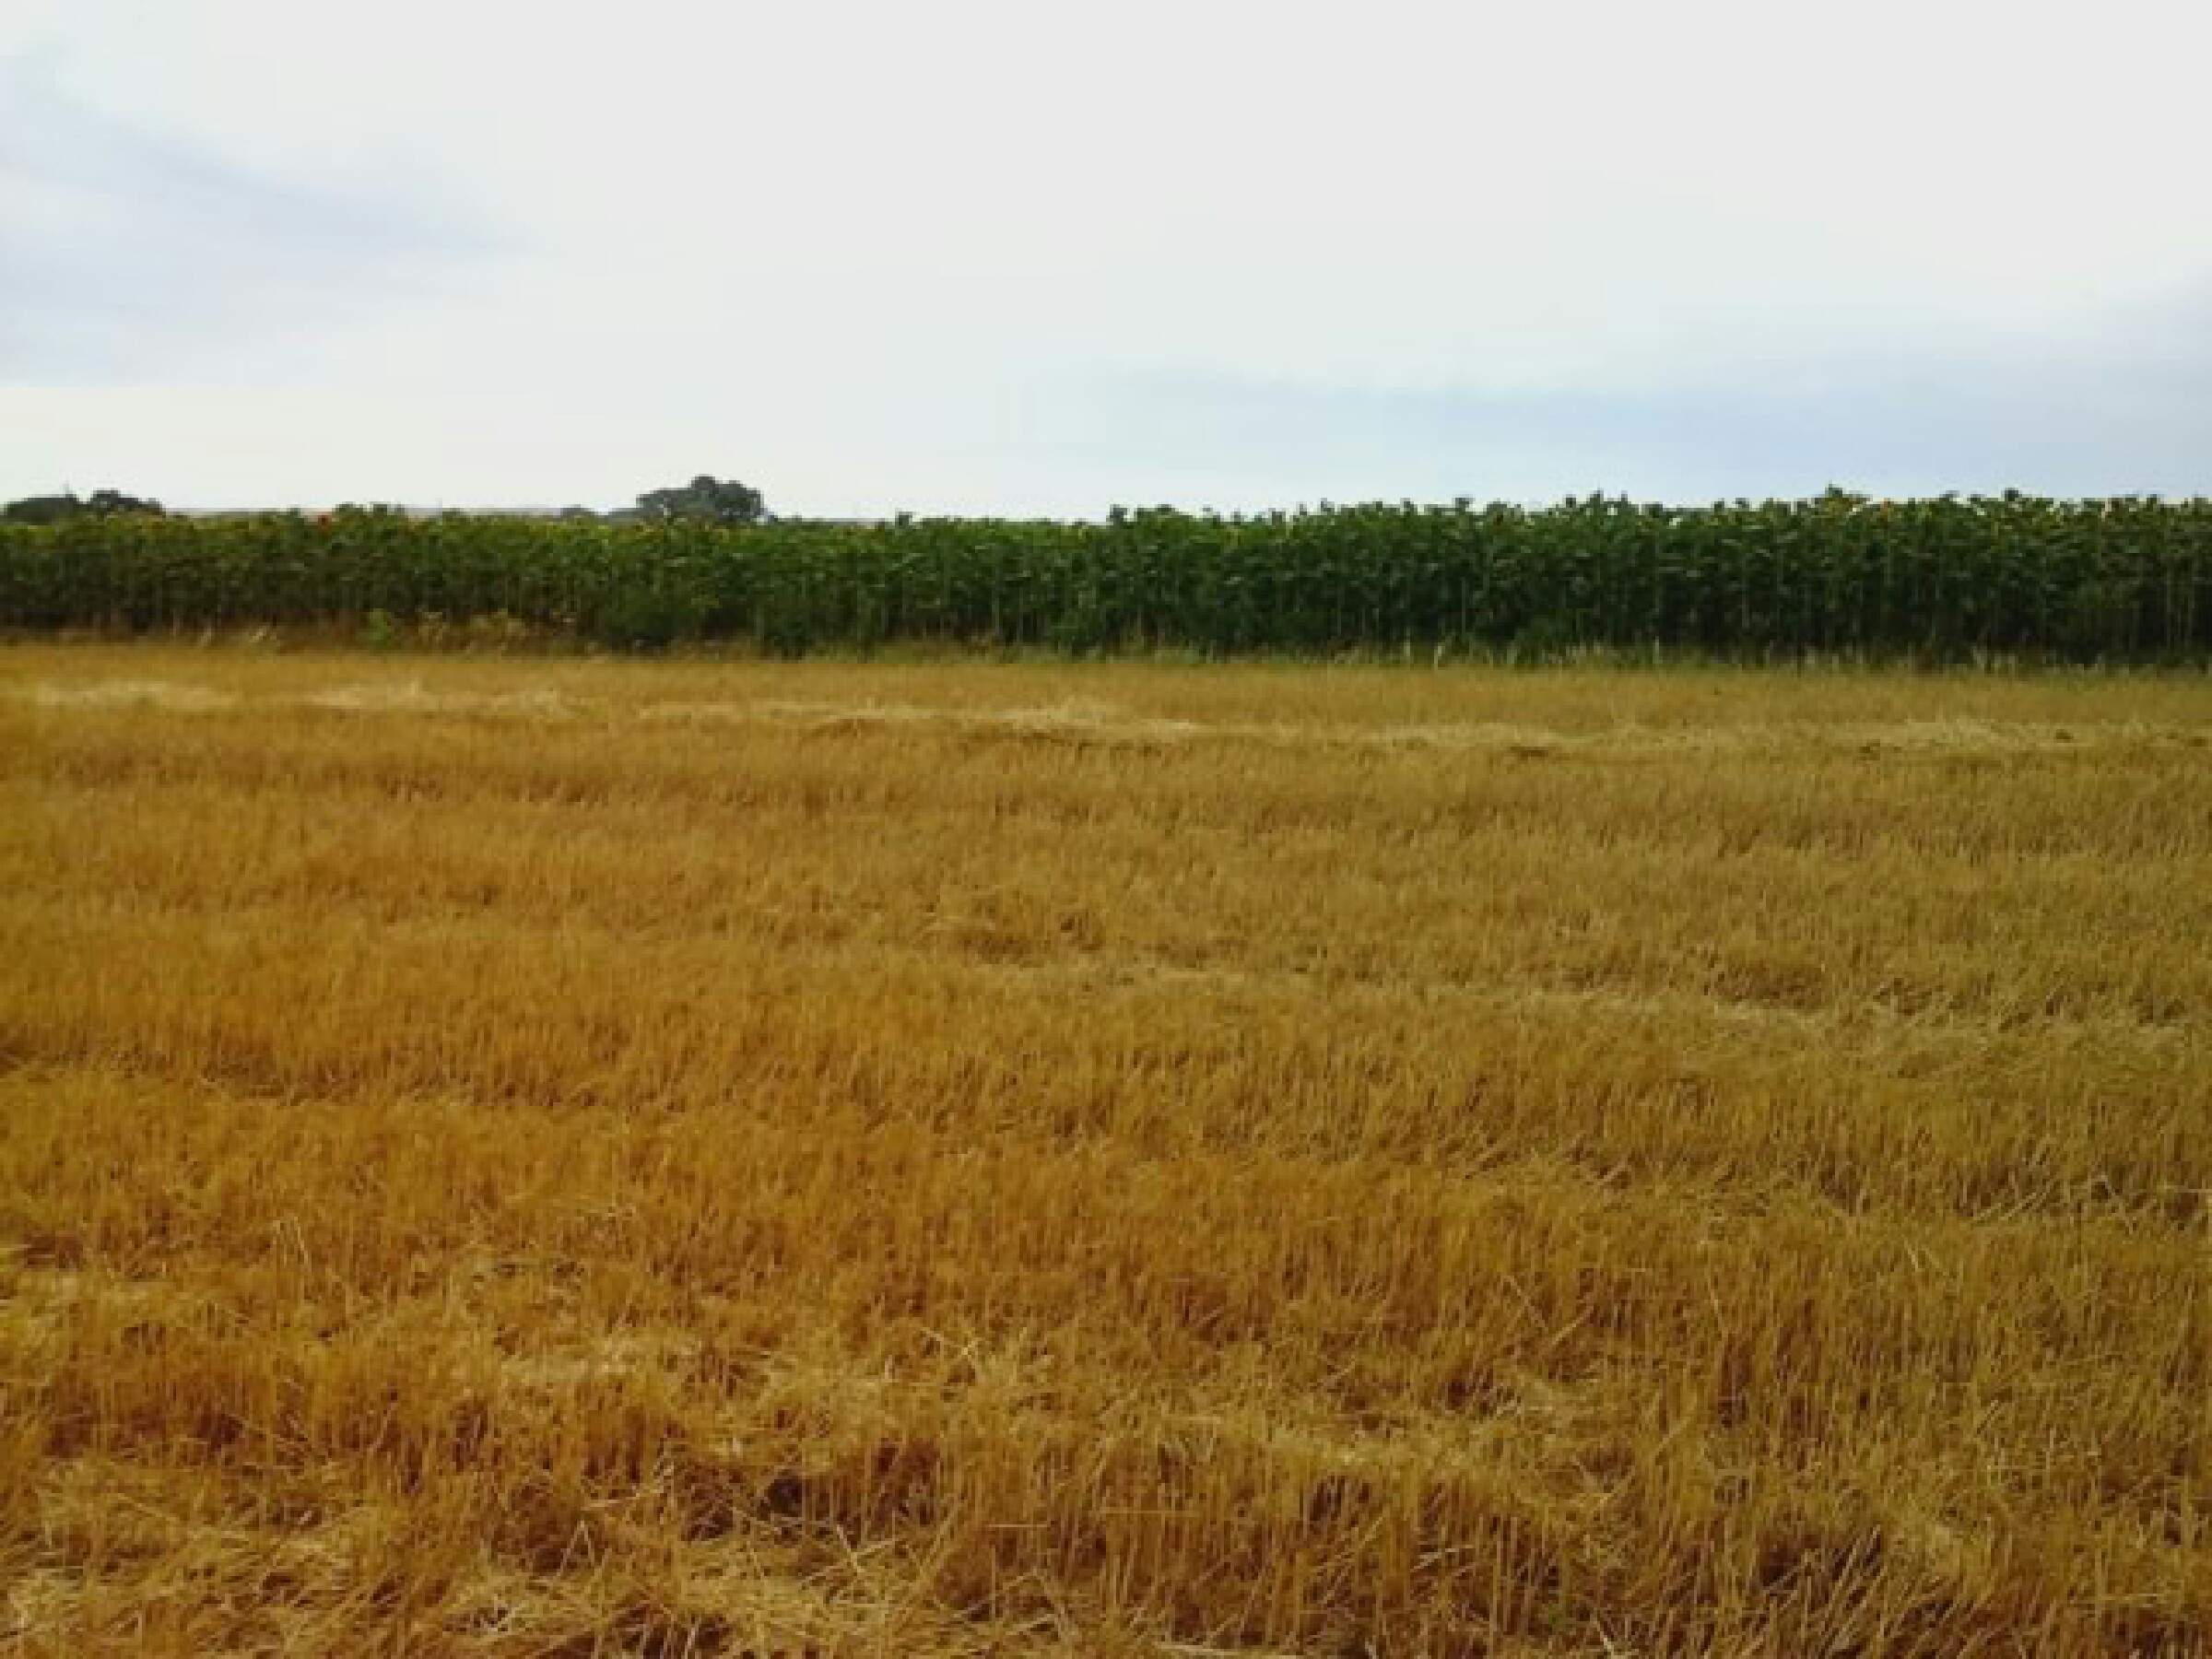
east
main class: Cropland
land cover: Common wheat
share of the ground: > 75 %
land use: Agriculture (excluding fallow land and kitchen gardens)
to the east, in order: Common wheat; Tracks; Grass margins; Sunflower
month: July
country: HU
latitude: 47.7133
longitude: 19.1767
